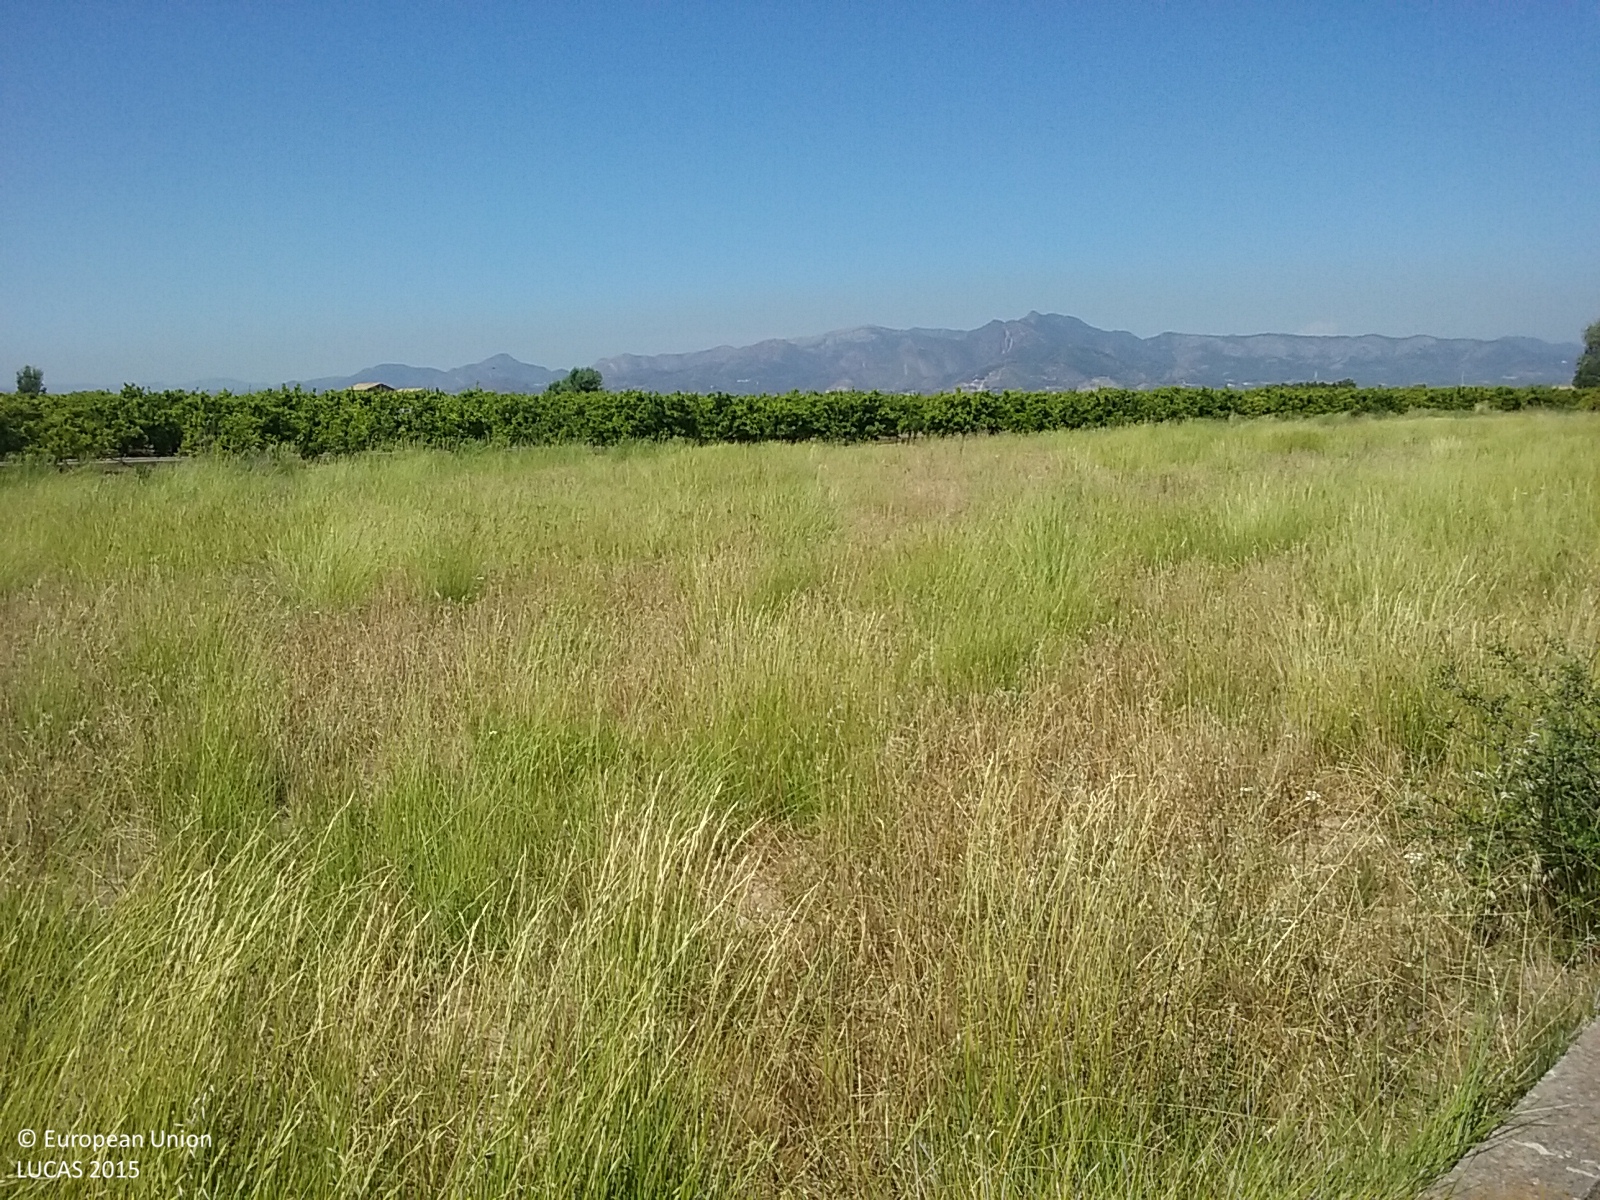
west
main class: Grassland
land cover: Grassland without tree/shrub cover
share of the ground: > 75 %
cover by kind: herbaceous plants 95 %, unconsolidated bare surface 5 %
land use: Abandoned areas
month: June
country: ES
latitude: 39.8530
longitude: -0.1103
